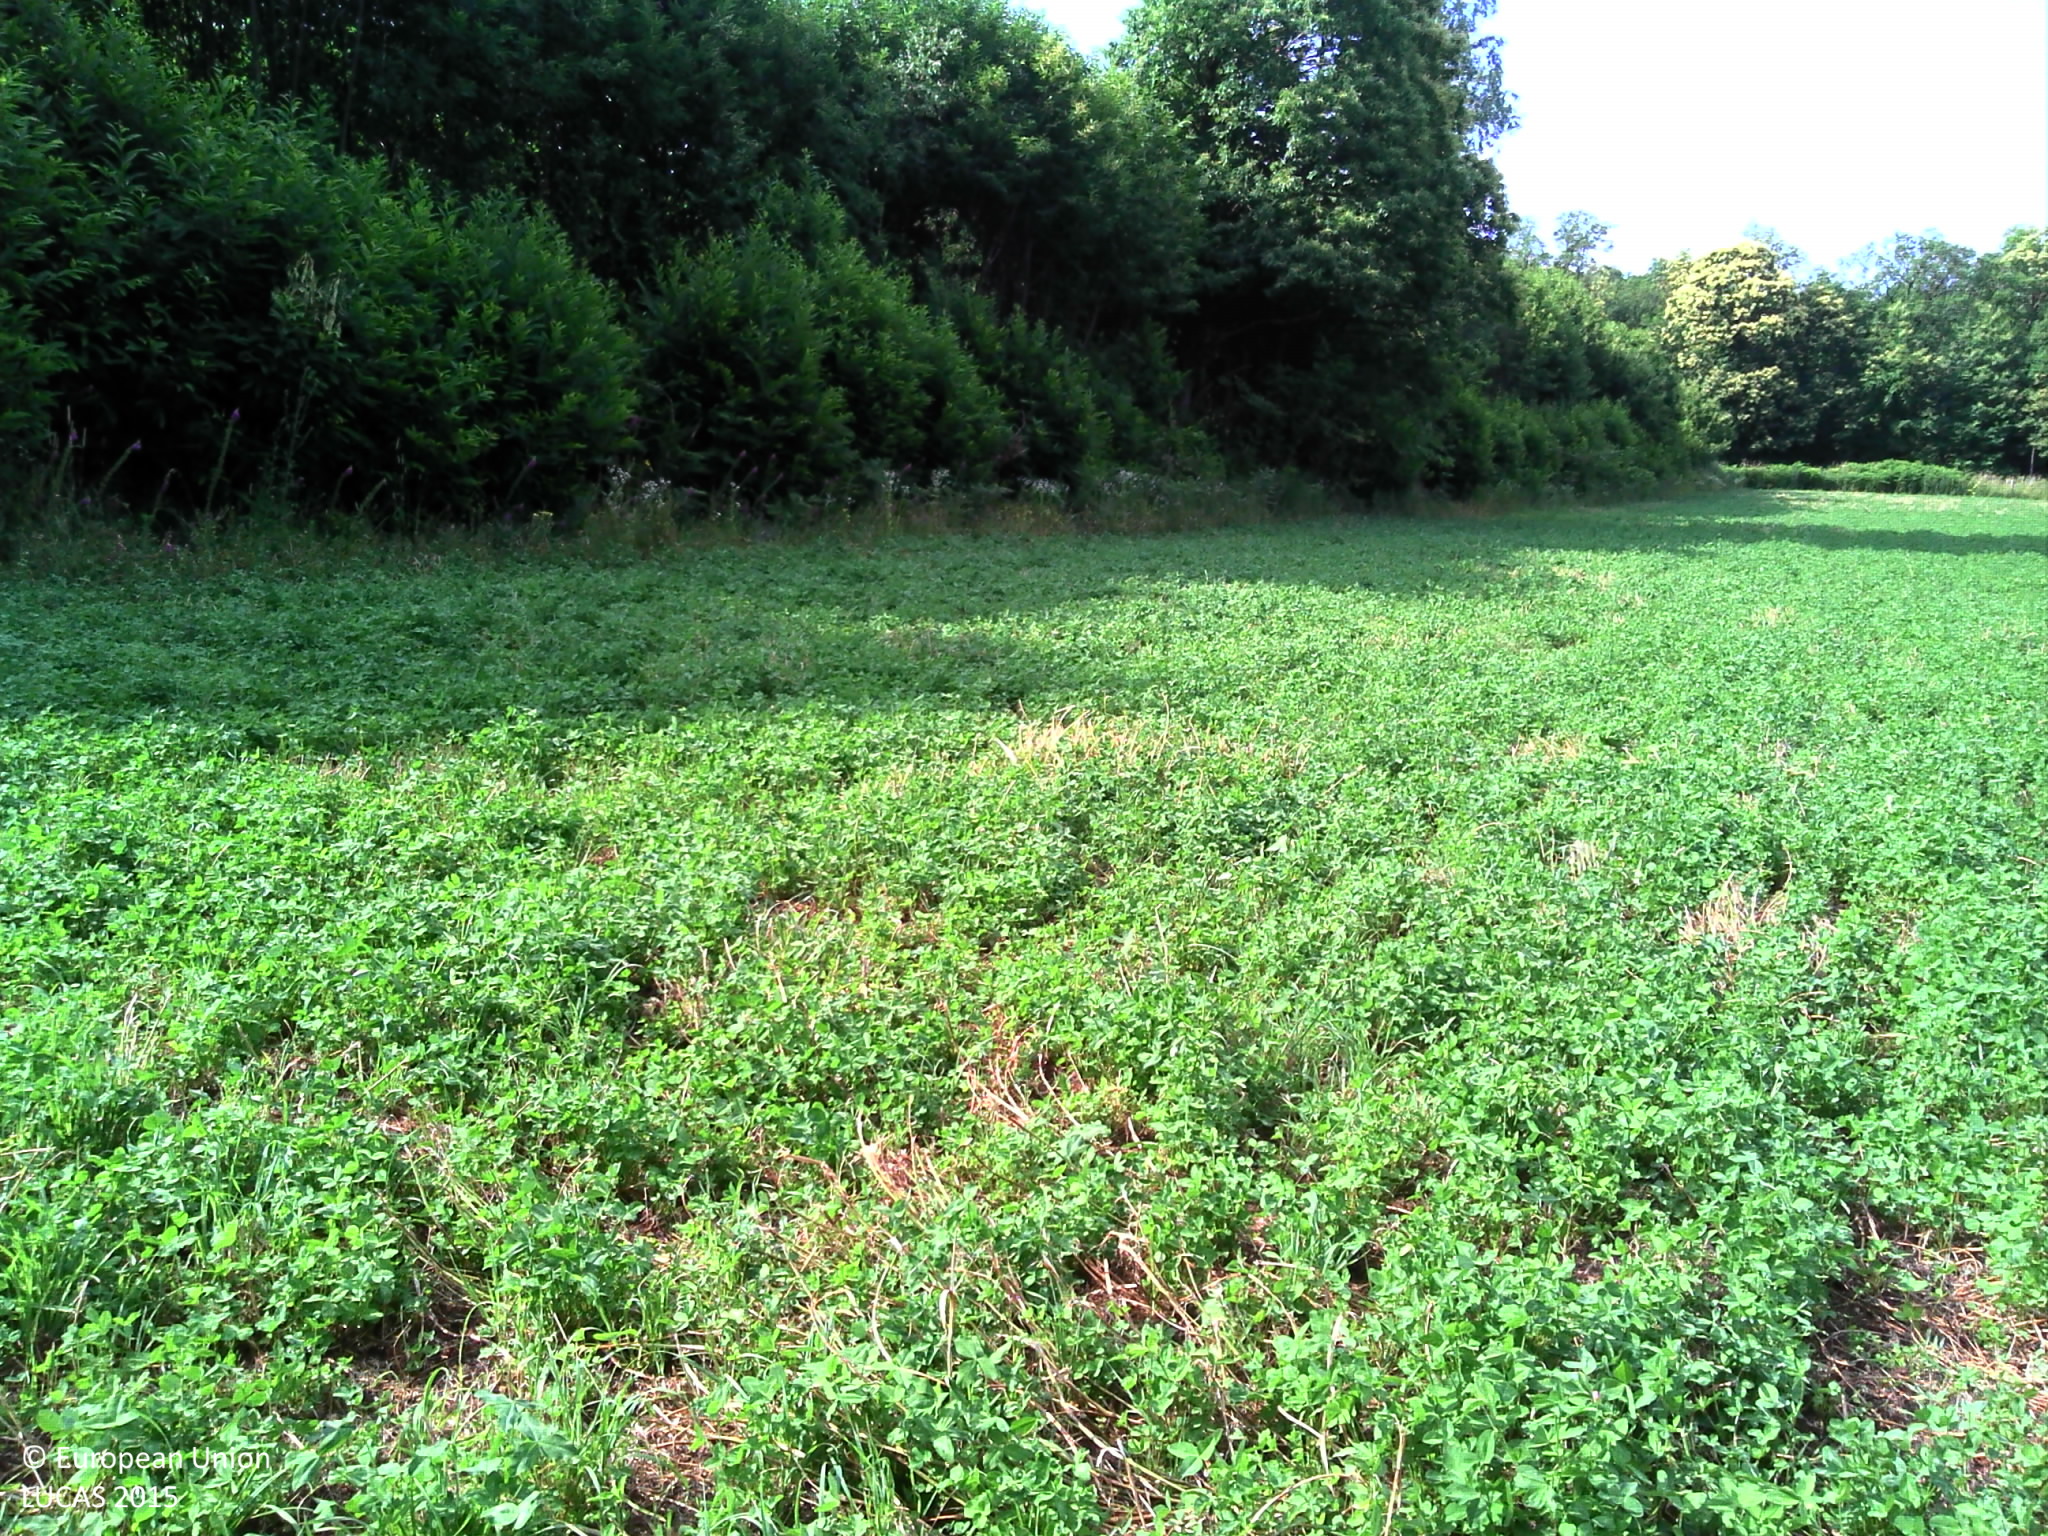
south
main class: Cropland
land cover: Clovers
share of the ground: > 75 %
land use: Agriculture (excluding fallow land and kitchen gardens)
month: July
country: FR
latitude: 46.0940
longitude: 1.3892
